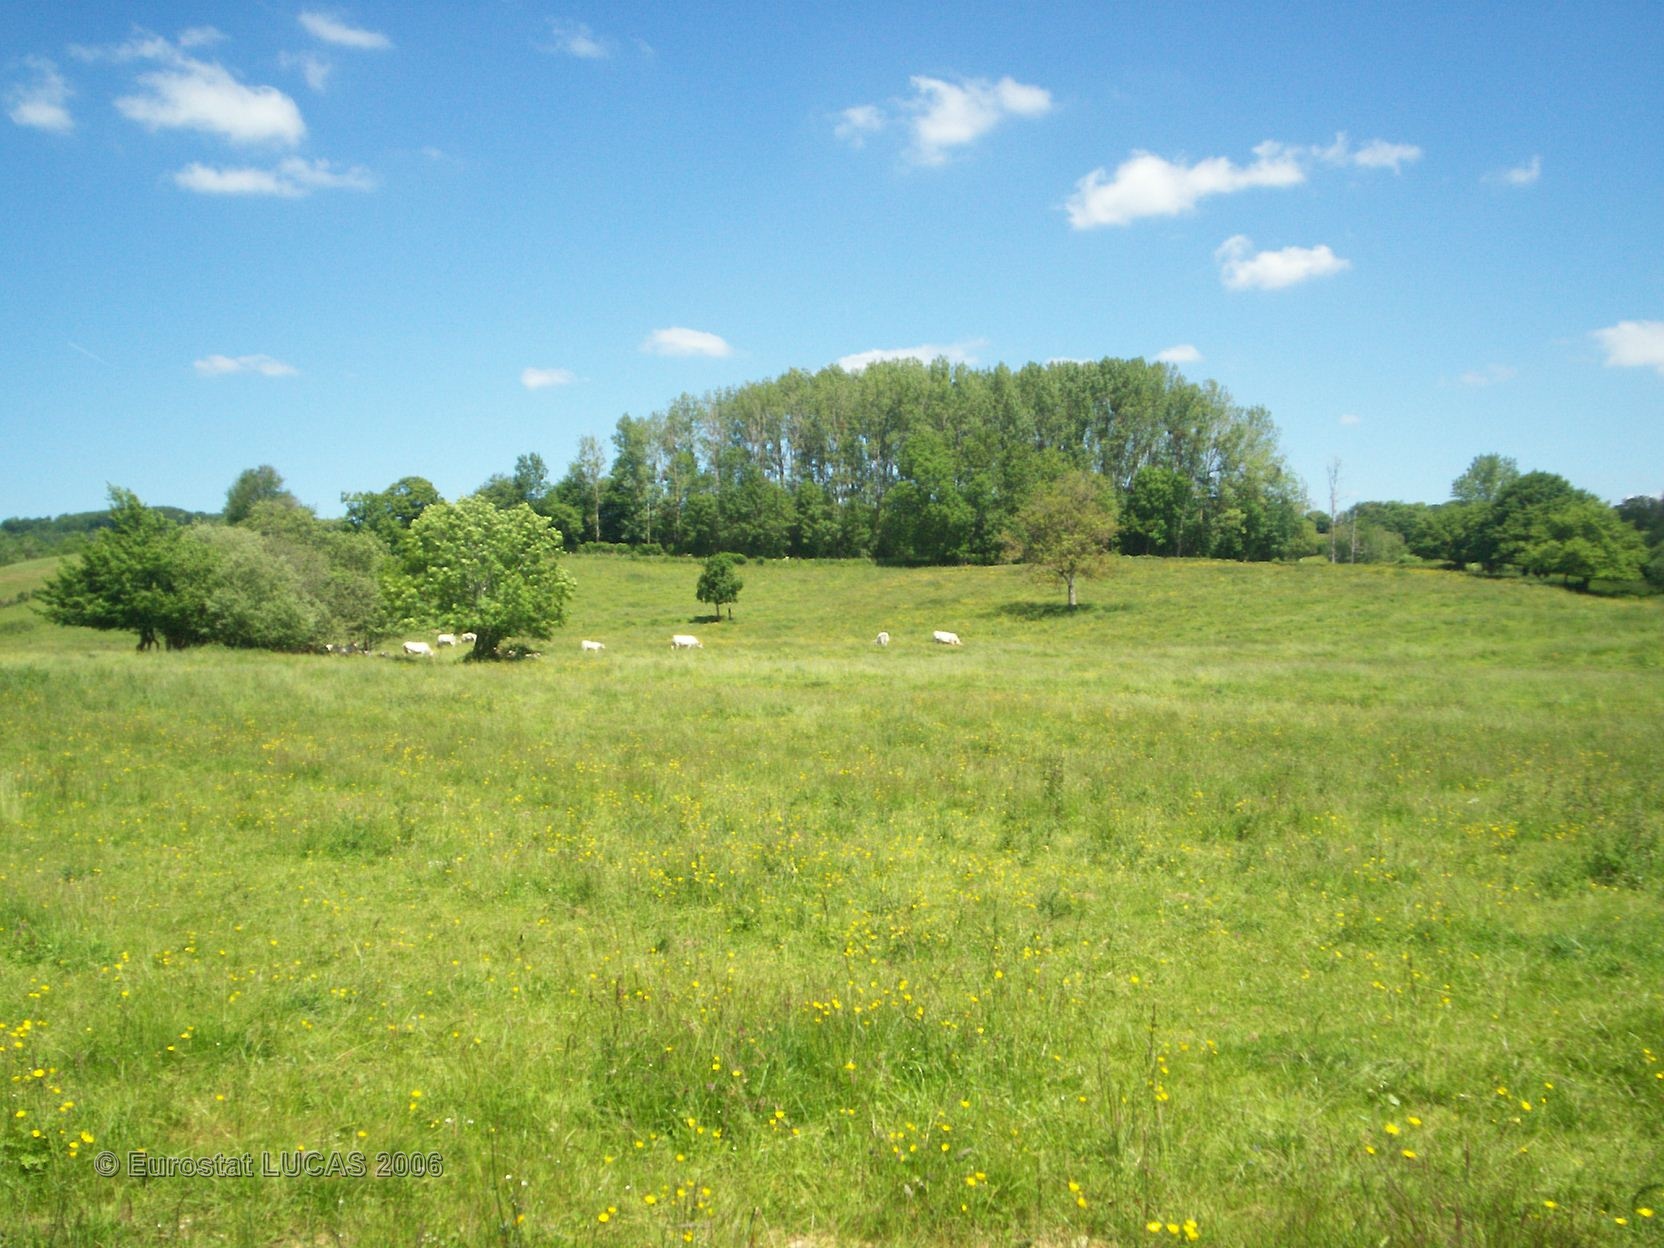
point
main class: Grassland
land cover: Grassland with sparse tree/shrub cover
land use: Agriculture (excluding fallow land and kitchen gardens)
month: June
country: FR
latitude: 46.1754
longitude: 2.9903
